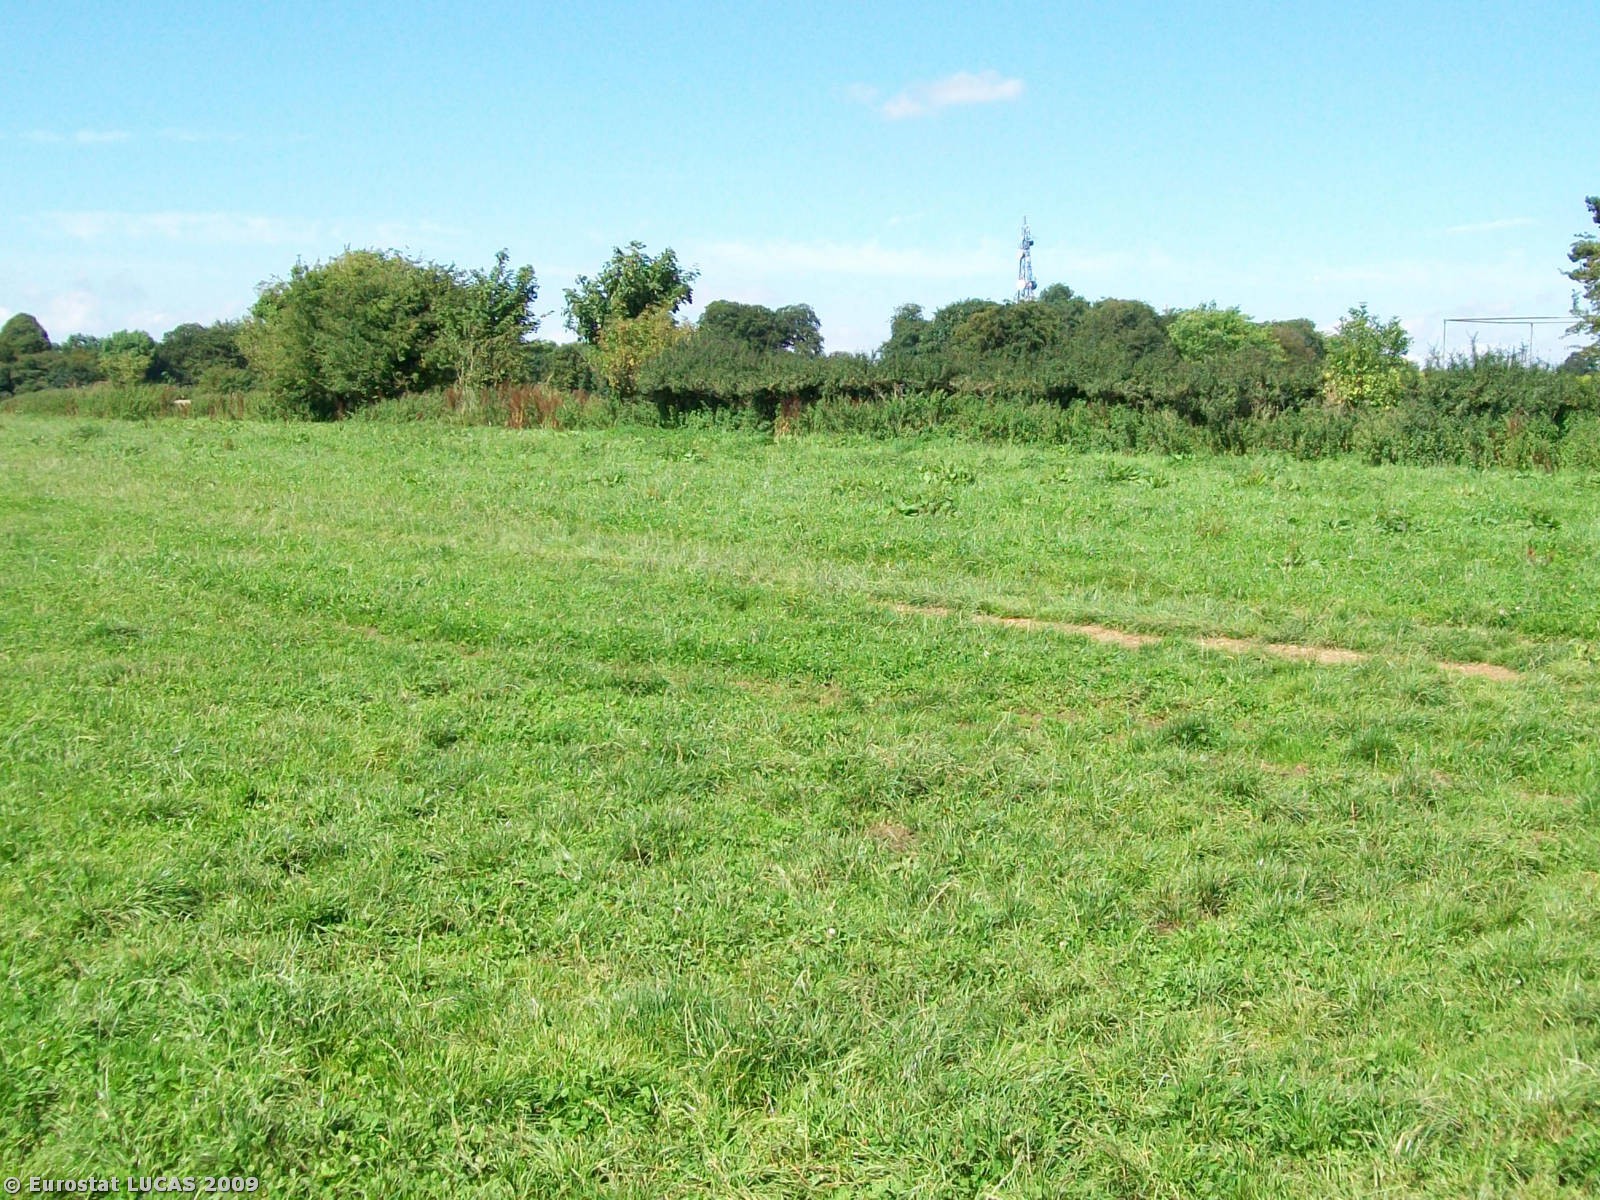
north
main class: Grassland
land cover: Grassland without tree/shrub cover
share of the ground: > 75 %
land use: Agriculture (excluding fallow land and kitchen gardens)
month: August
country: GB
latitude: 51.6612
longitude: -2.3081
